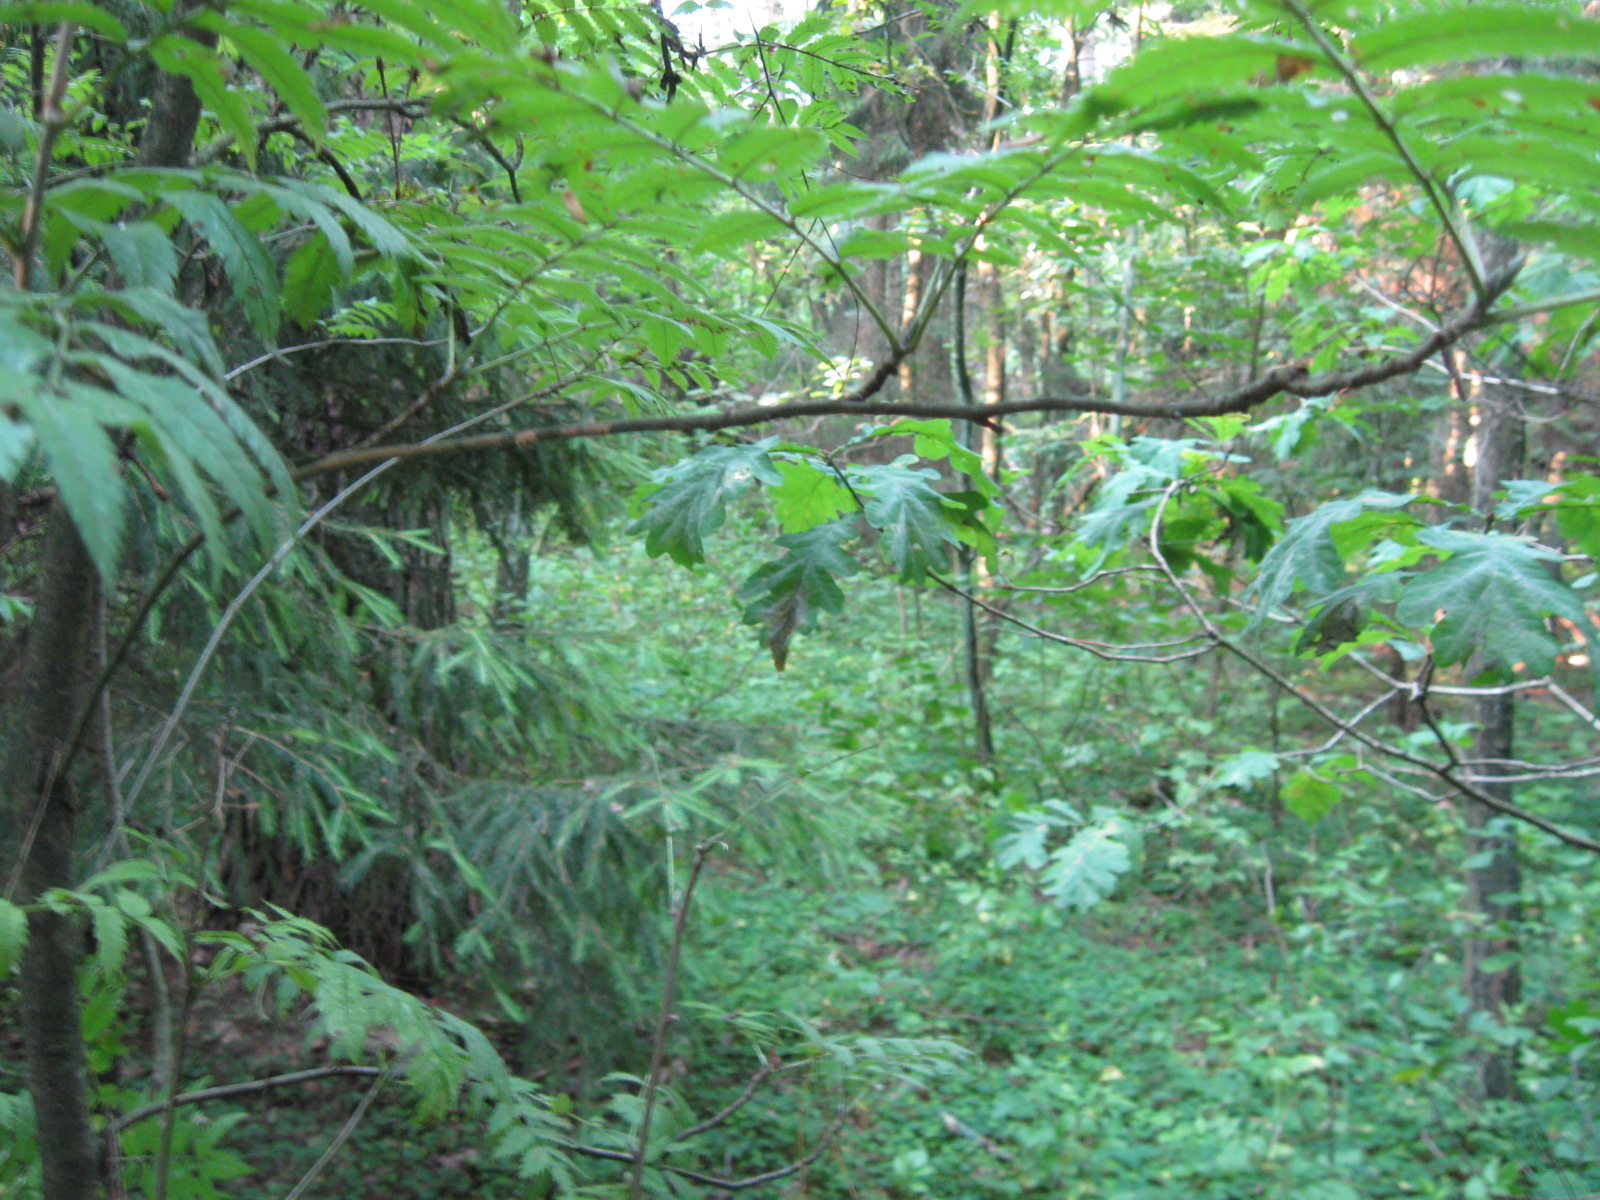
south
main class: Woodland
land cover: Other mixed woodland
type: hemiboreal forest and nemoral coniferous forest and mixed broadleaved-coniferous forest
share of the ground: > 75 %
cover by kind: coniferous forest trees 65 %, broadleaved forest trees 30 %, herbaceous plants 5 %
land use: Forestry
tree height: > 5 m
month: August
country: LT
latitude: 54.8107
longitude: 23.3507
